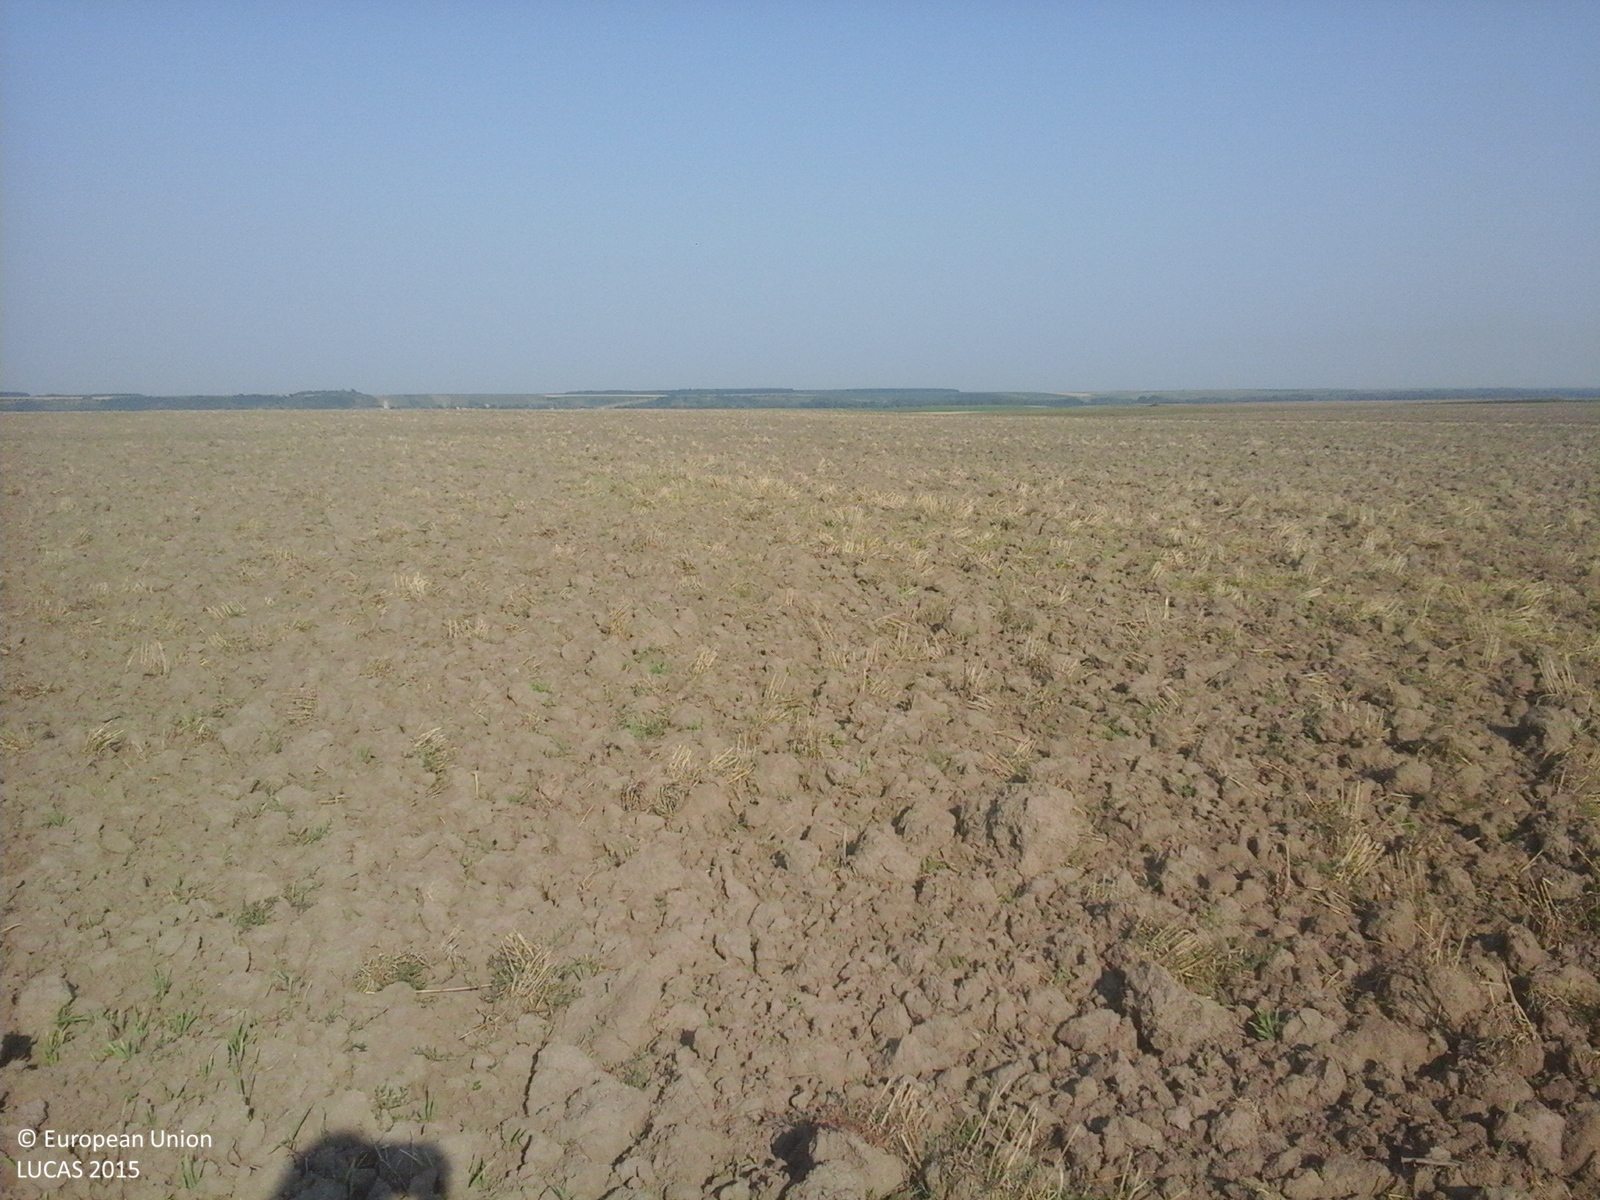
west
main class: Cropland
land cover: Rye
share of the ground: < 10 %
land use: Agriculture (excluding fallow land and kitchen gardens)
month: July
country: RO
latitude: 44.4977
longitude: 24.7527
